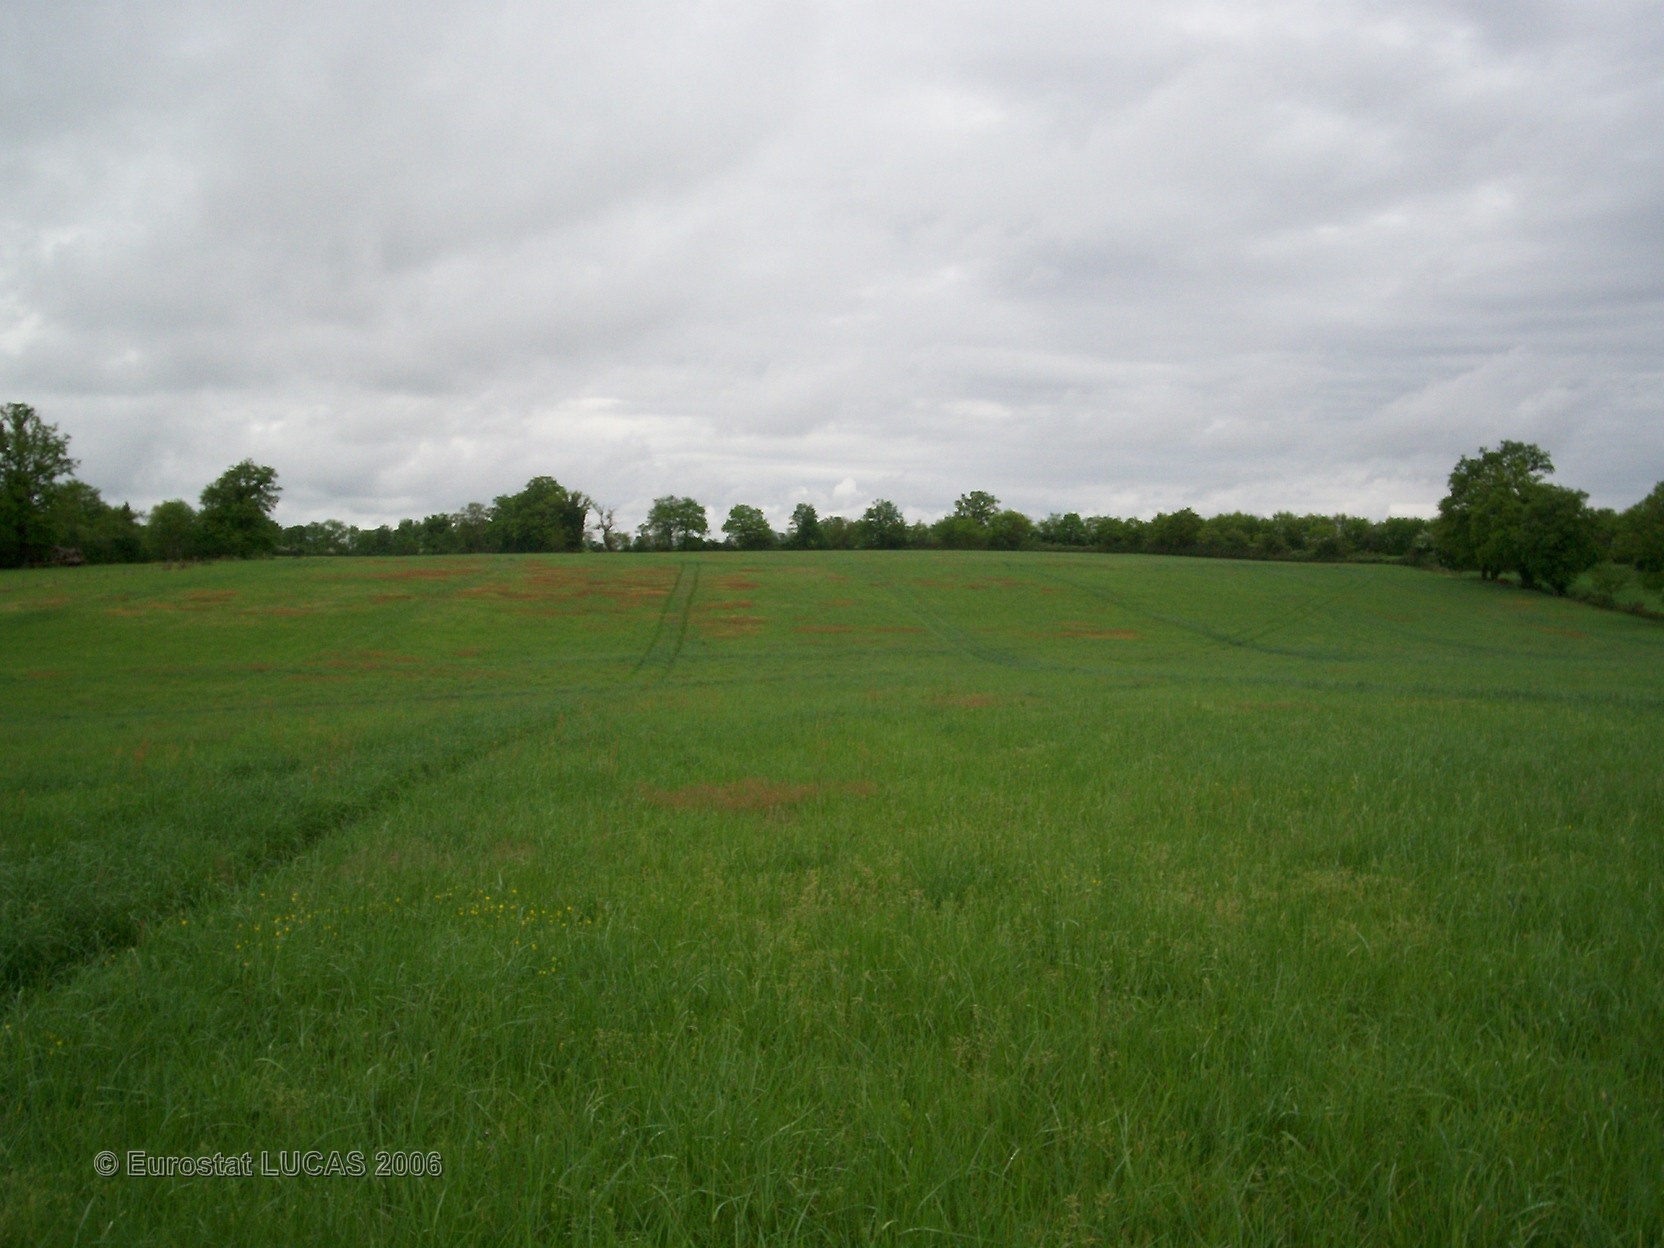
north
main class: Grassland
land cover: Grassland without tree/shrub cover
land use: Agriculture (excluding fallow land and kitchen gardens)
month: May
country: FR
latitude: 46.0375
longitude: 0.5134
